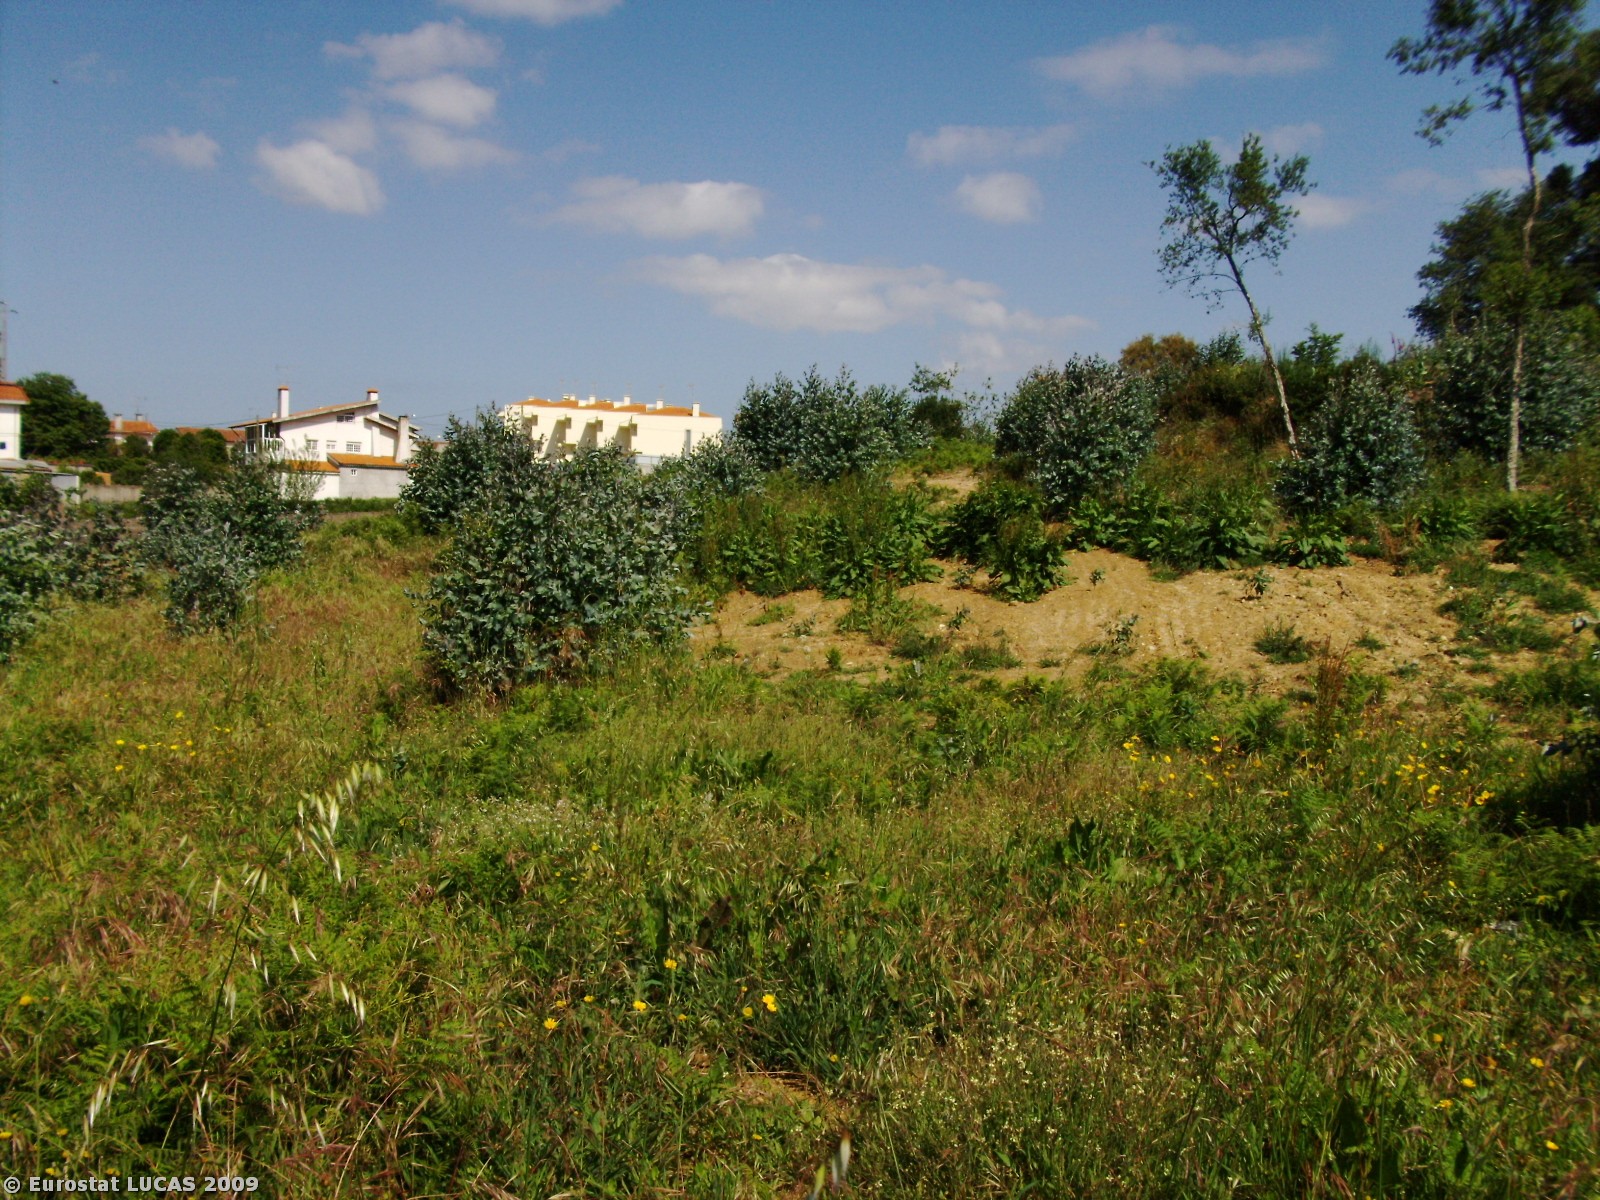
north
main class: Woodland
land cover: Broadleaved woodland
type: plantations and self-sown exotic forest
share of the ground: 25 - 50 %
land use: Forestry
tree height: > 5 m
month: May
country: PT
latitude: 40.8893
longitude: -8.5303
